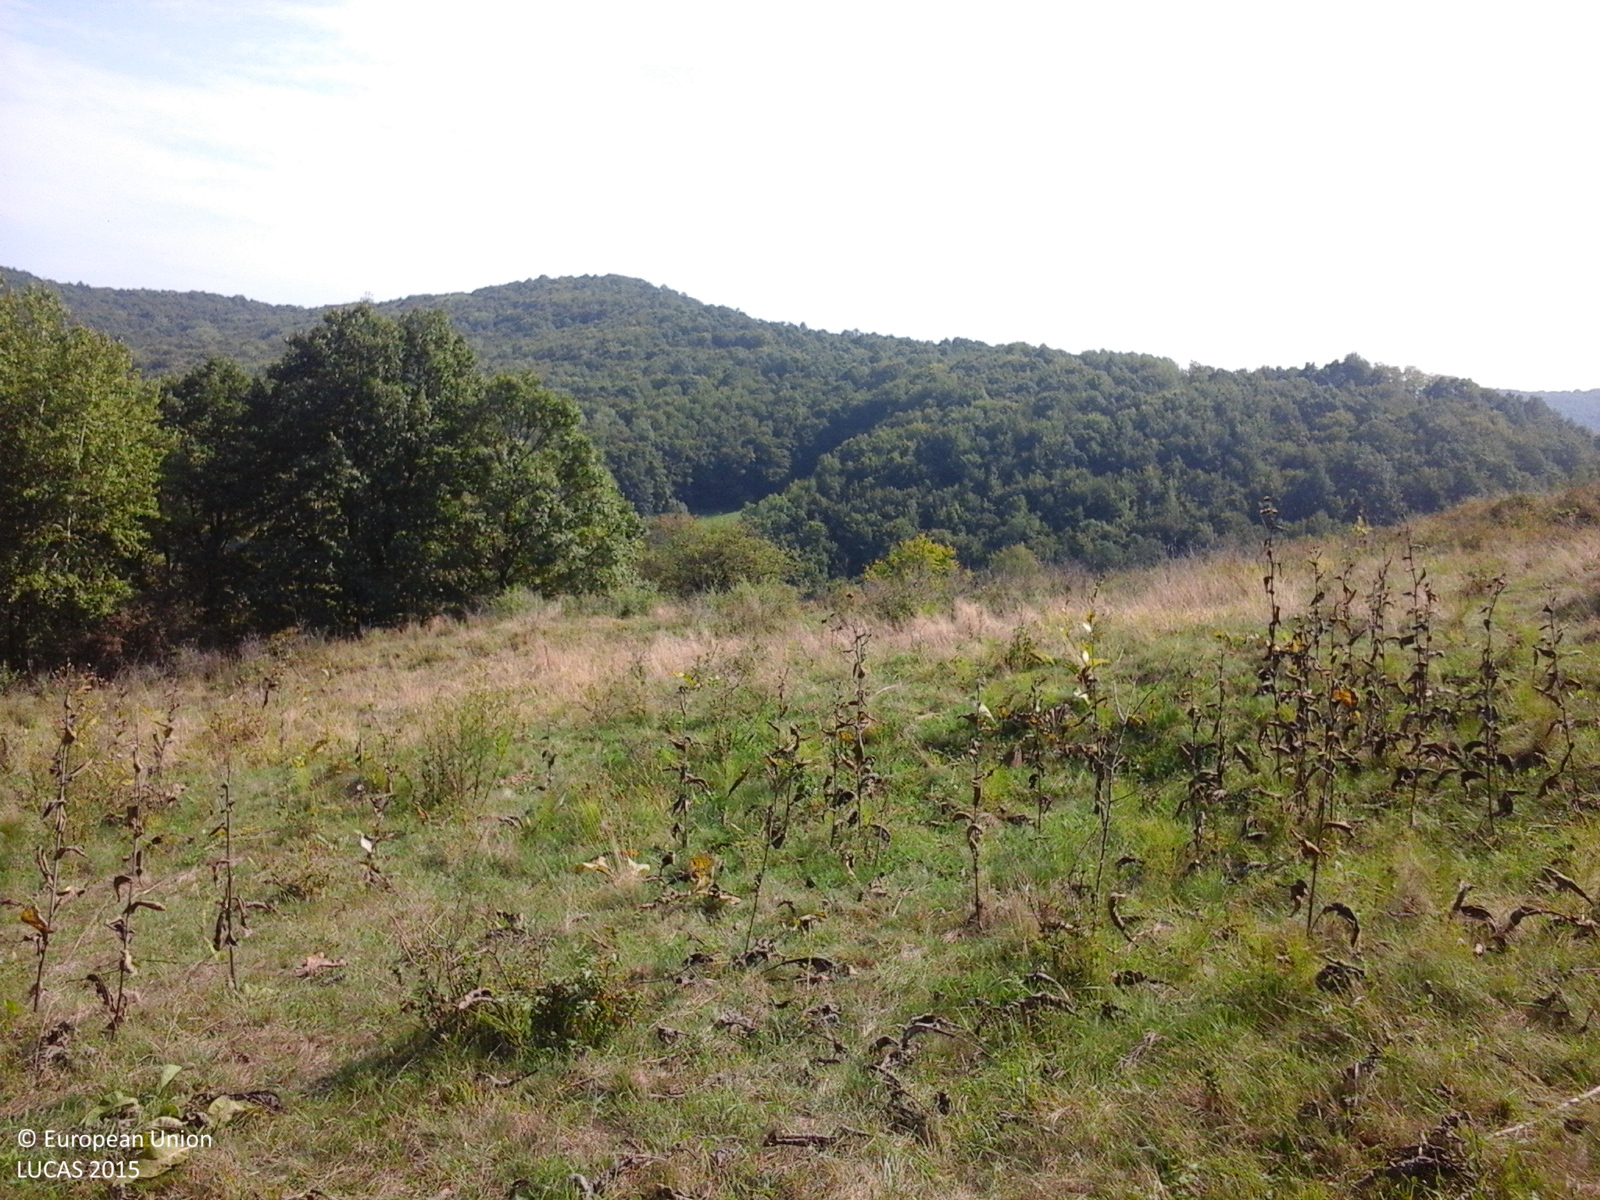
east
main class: Grassland
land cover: Spontaneously vegetated surfaces
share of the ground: > 75 %
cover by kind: herbaceous plants 100 %
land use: Fallow land
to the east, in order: Spontaneously vegetated surfaces; Grassland with sparse tree/shrub cover; Broadleaved woodland; Grassland with sparse tree/shrub cover; Grassland without tree/shrub cover; Tracks; Grassland with sparse tree/shrub cover; Shrubland with sparse tree cover
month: September
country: RO
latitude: 45.9680
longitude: 22.8947
